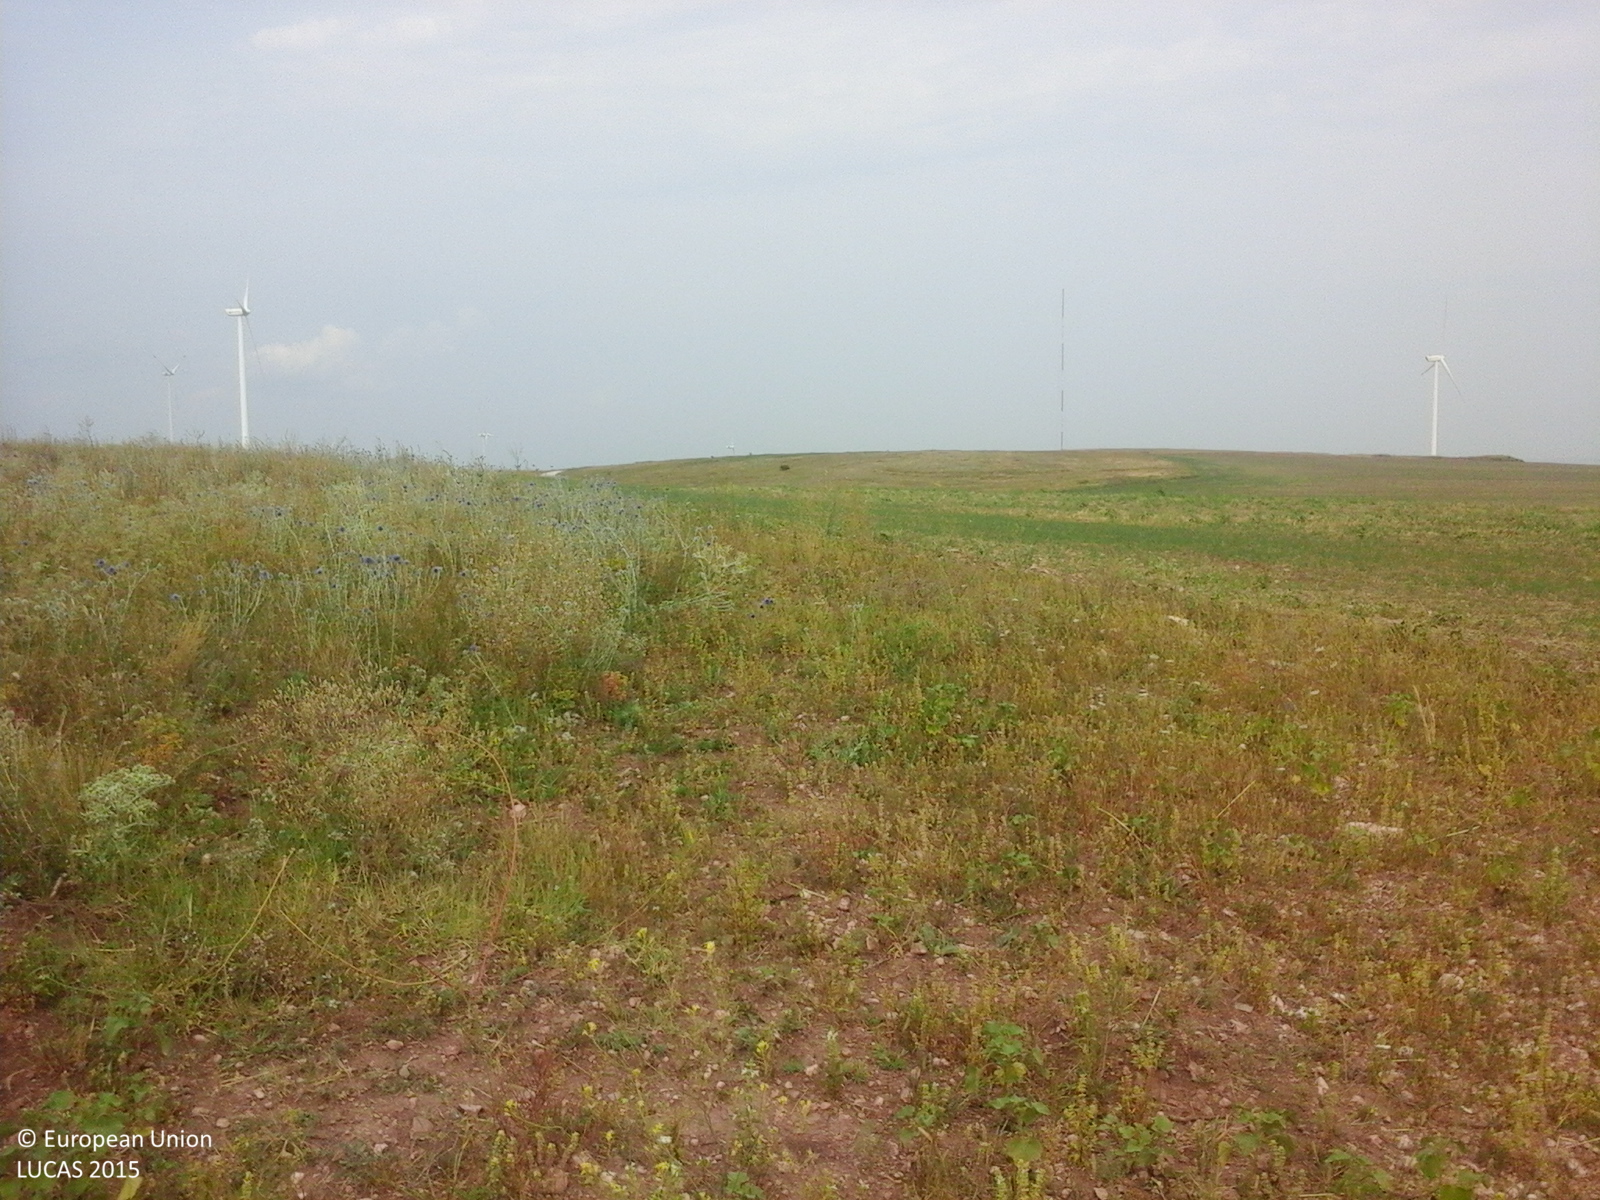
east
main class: Grassland
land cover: Spontaneously vegetated surfaces
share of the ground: 50 - 75 %
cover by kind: herbaceous plants 100 %
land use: Fallow land
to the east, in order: Spontaneously vegetated surfaces; Common wheat; Grassland without tree/shrub cover
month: July
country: RO
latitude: 45.0101
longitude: 28.8297
